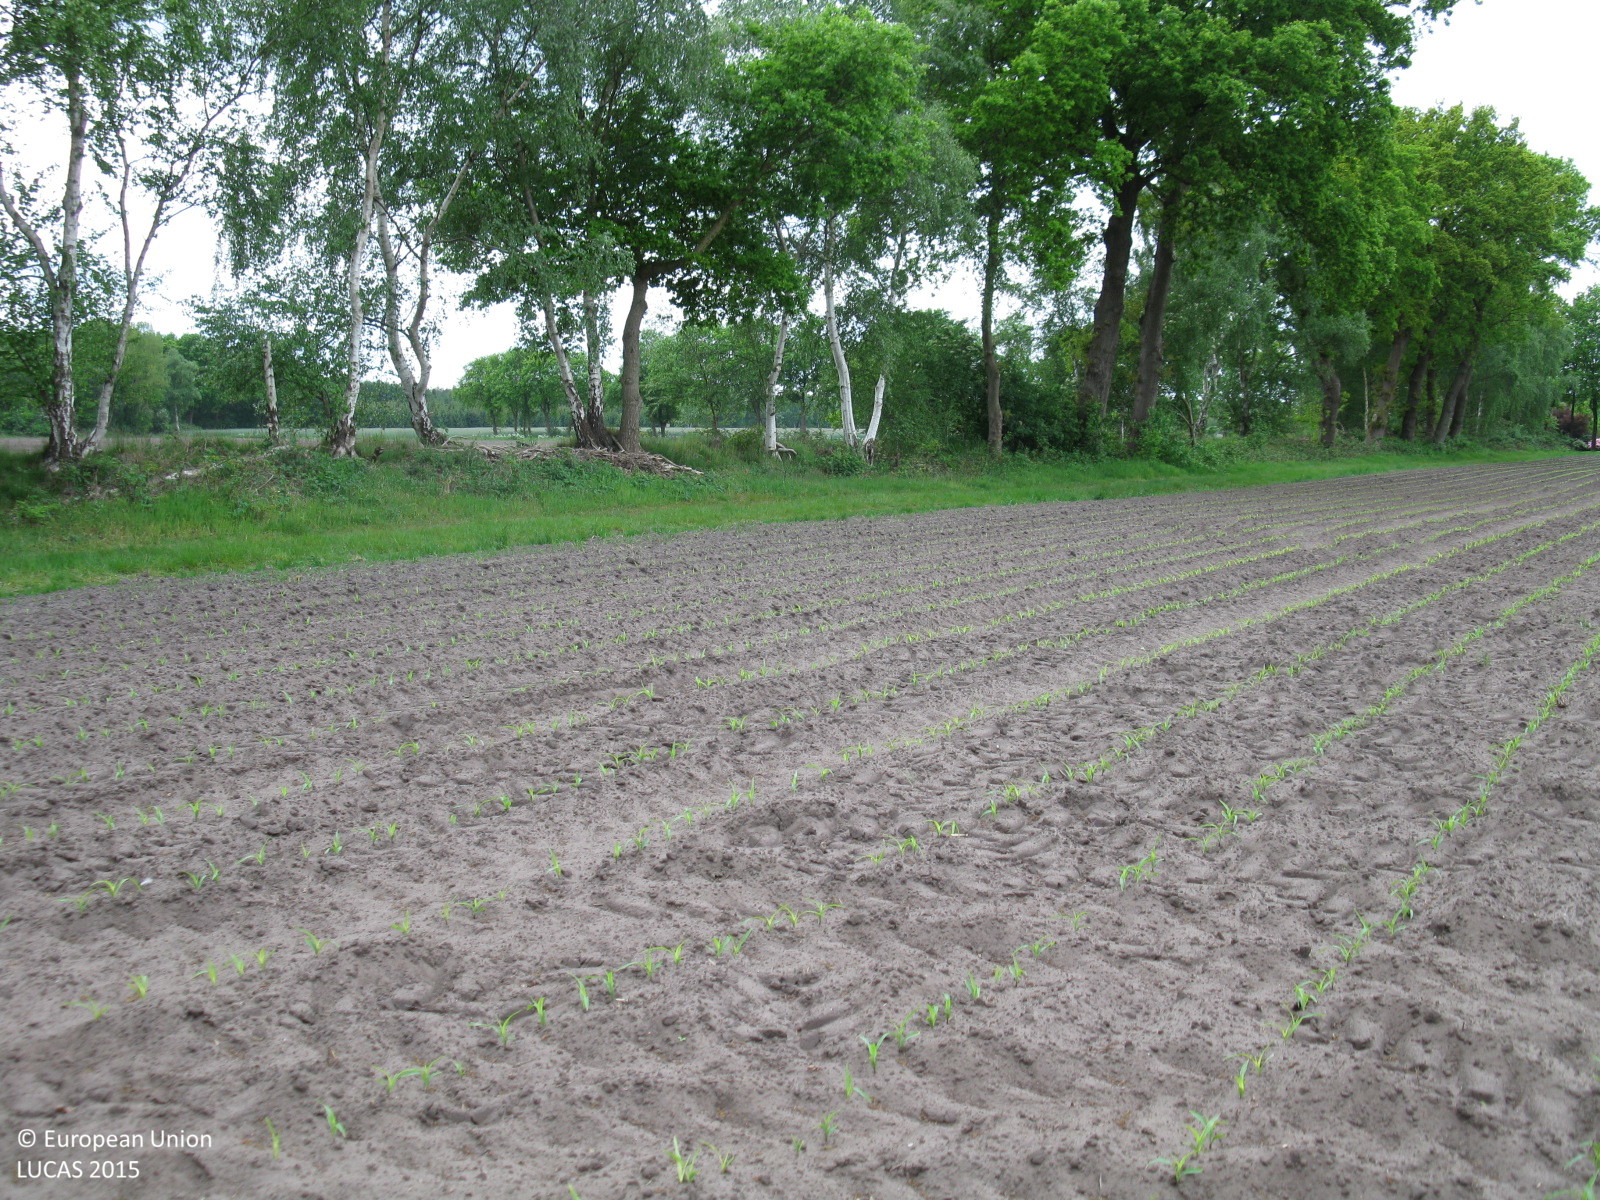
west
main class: Cropland
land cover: Maize
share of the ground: < 10 %
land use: Agriculture (excluding fallow land and kitchen gardens)
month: May
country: DE
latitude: 52.9708
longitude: 7.9308
